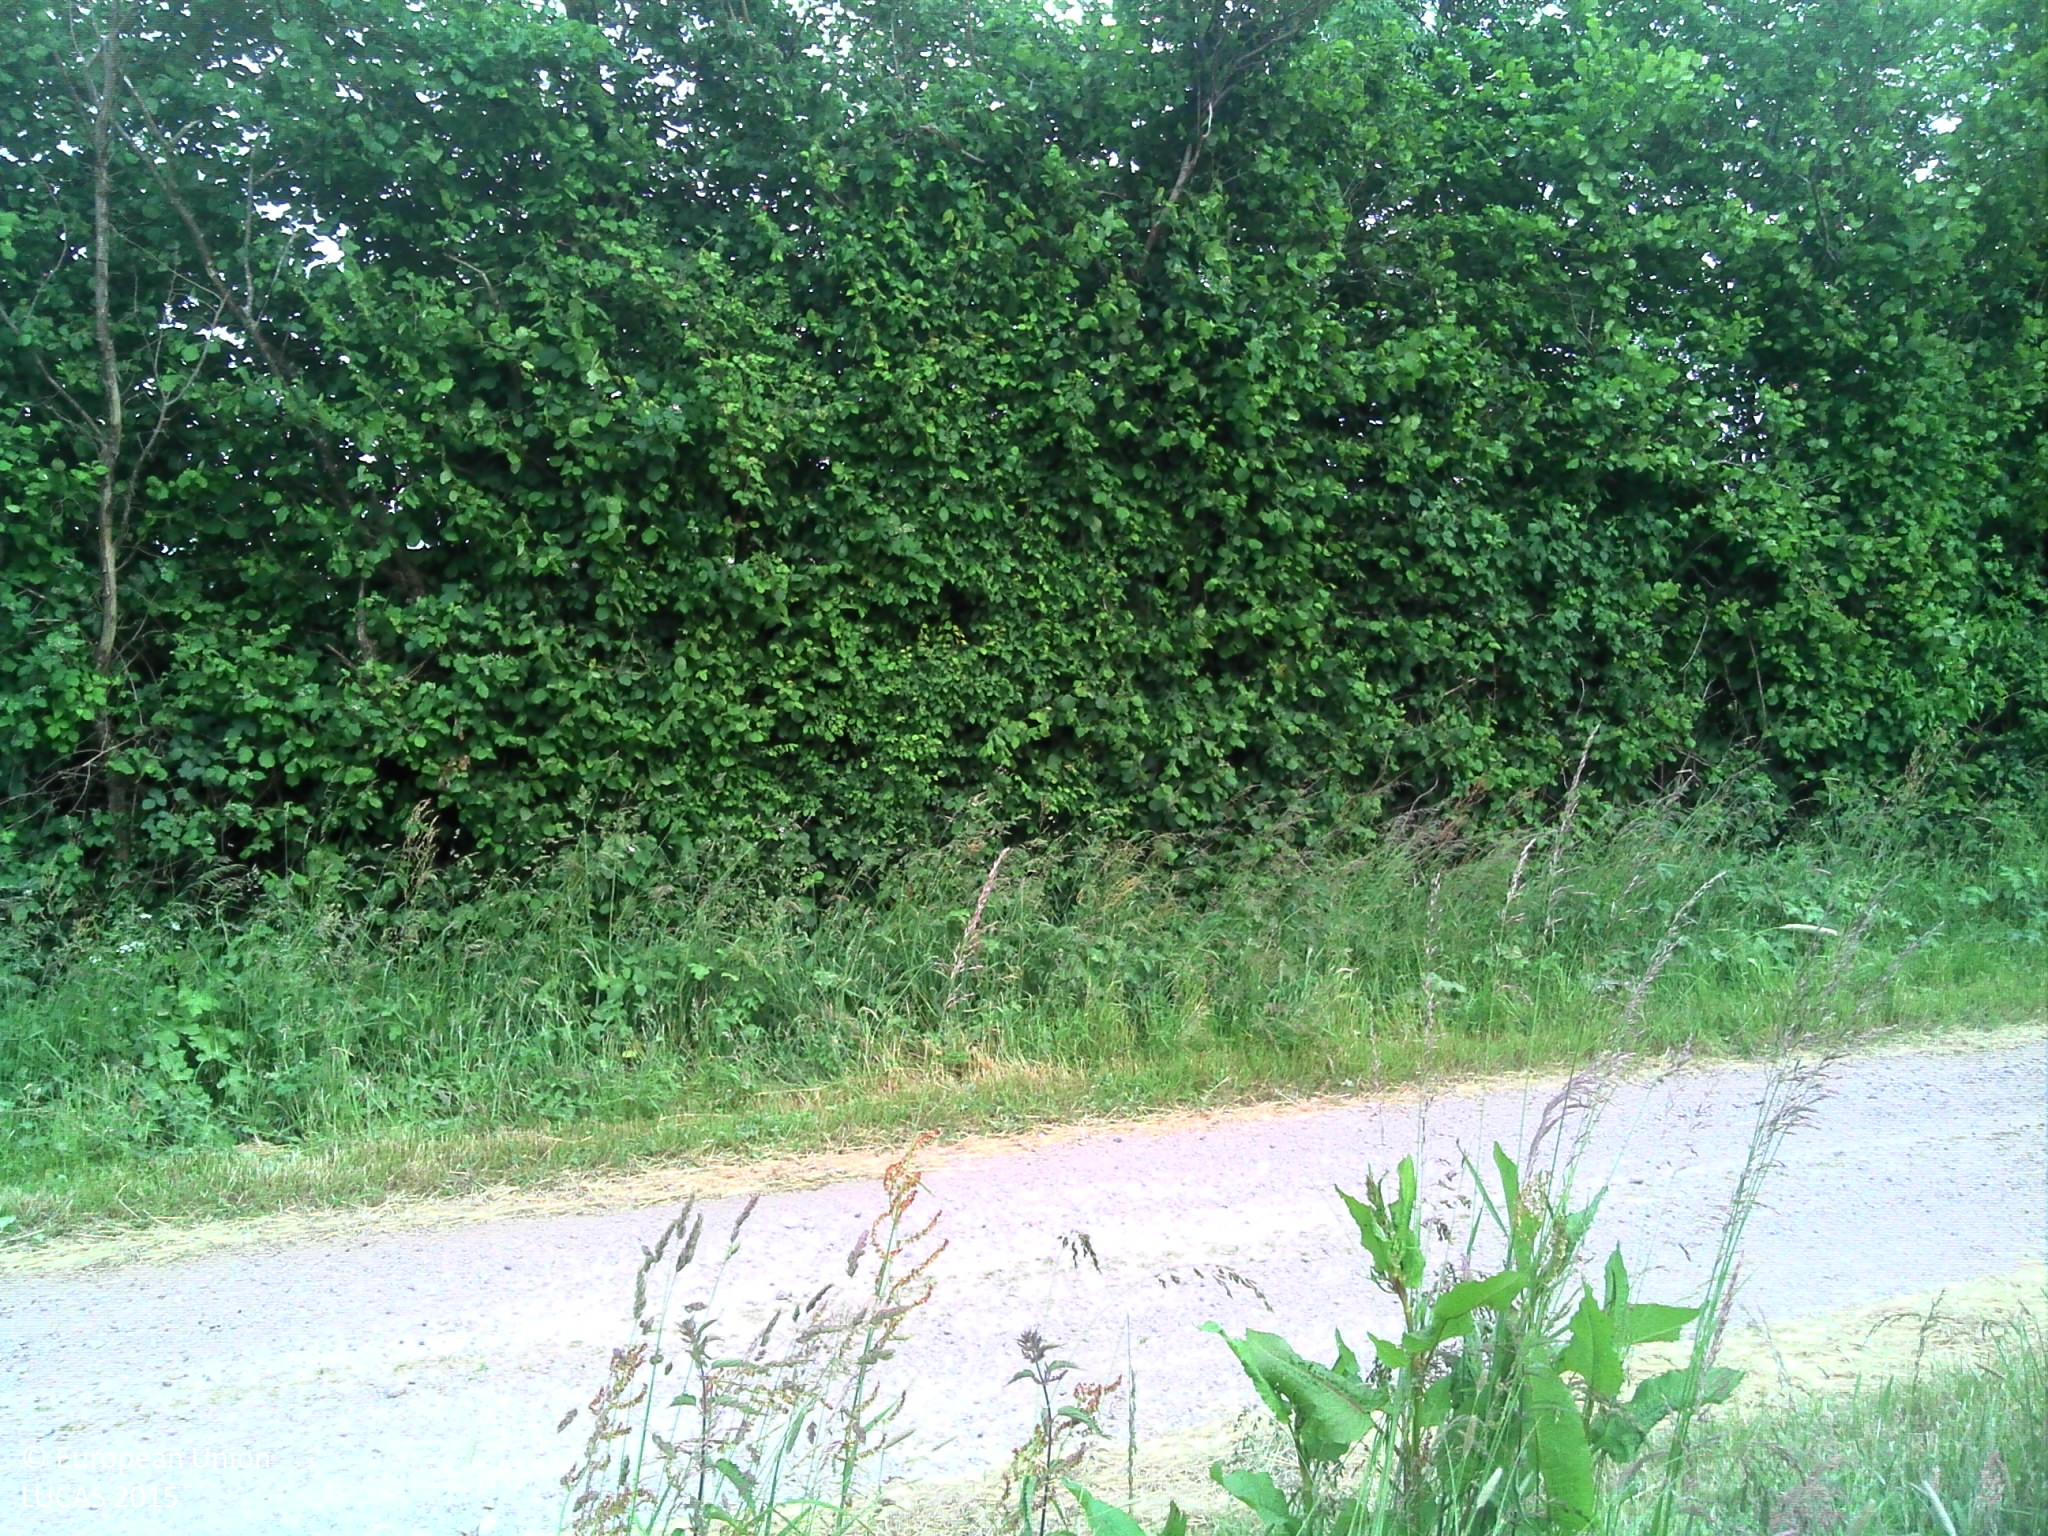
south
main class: Cropland
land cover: Dry pulses
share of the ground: > 75 %
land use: Agriculture (excluding fallow land and kitchen gardens)
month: June
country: FR
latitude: 48.5654
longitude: 0.2019
